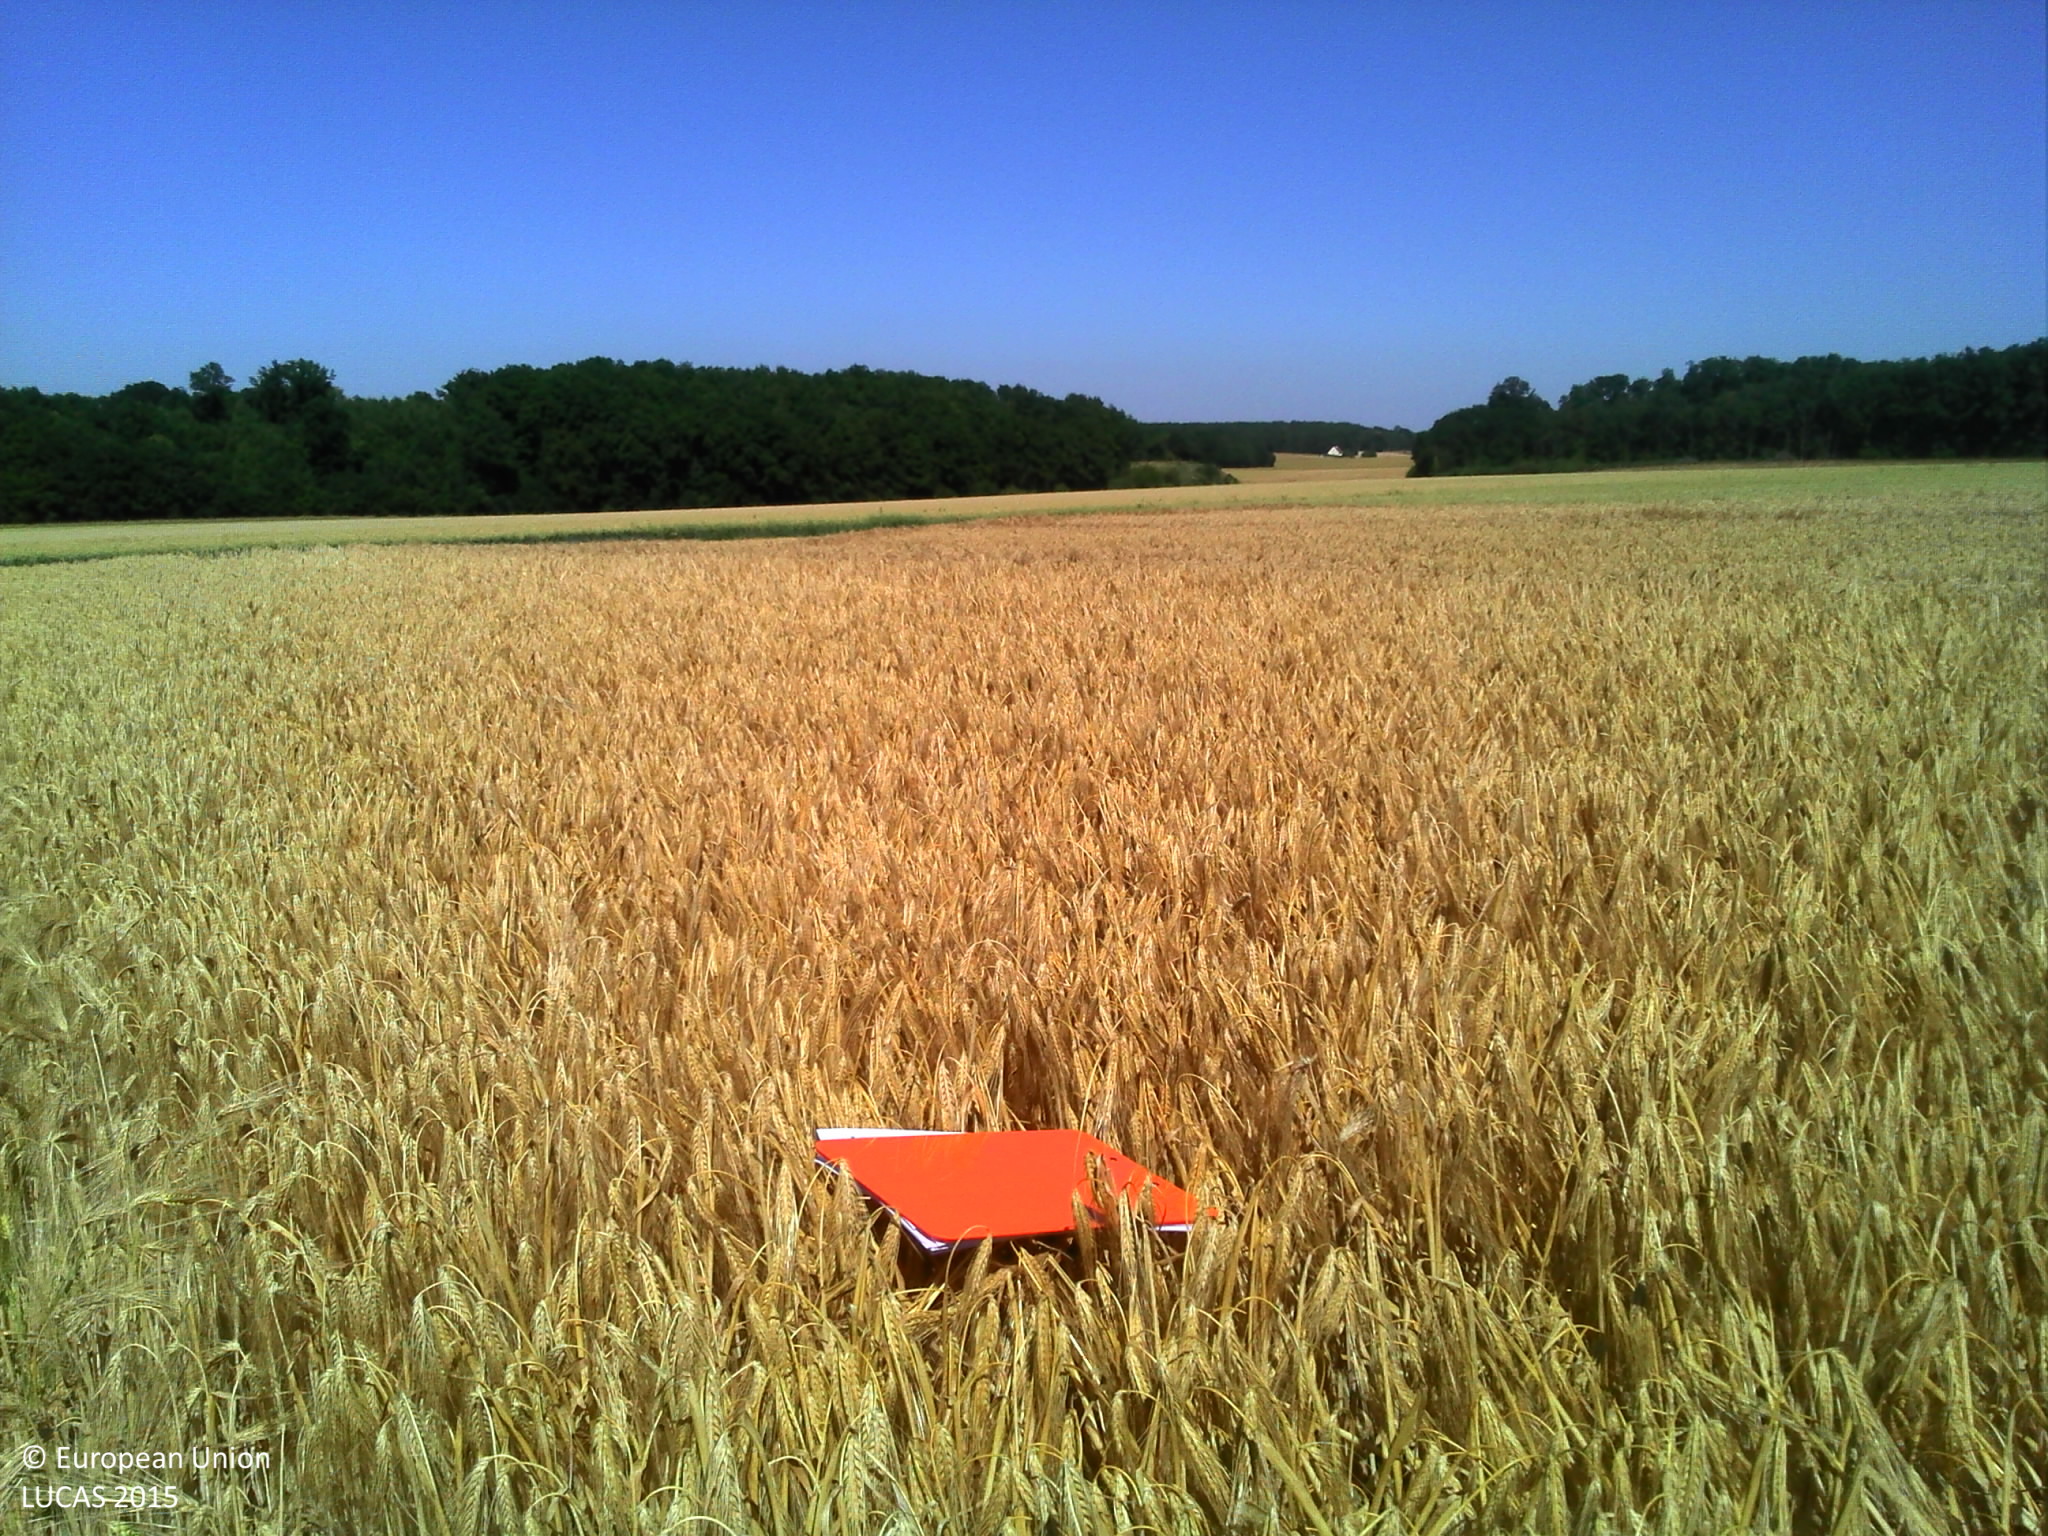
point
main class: Cropland
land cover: Barley
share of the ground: > 75 %
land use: Agriculture (excluding fallow land and kitchen gardens)
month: June
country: FR
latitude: 48.9789
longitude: 1.2497
